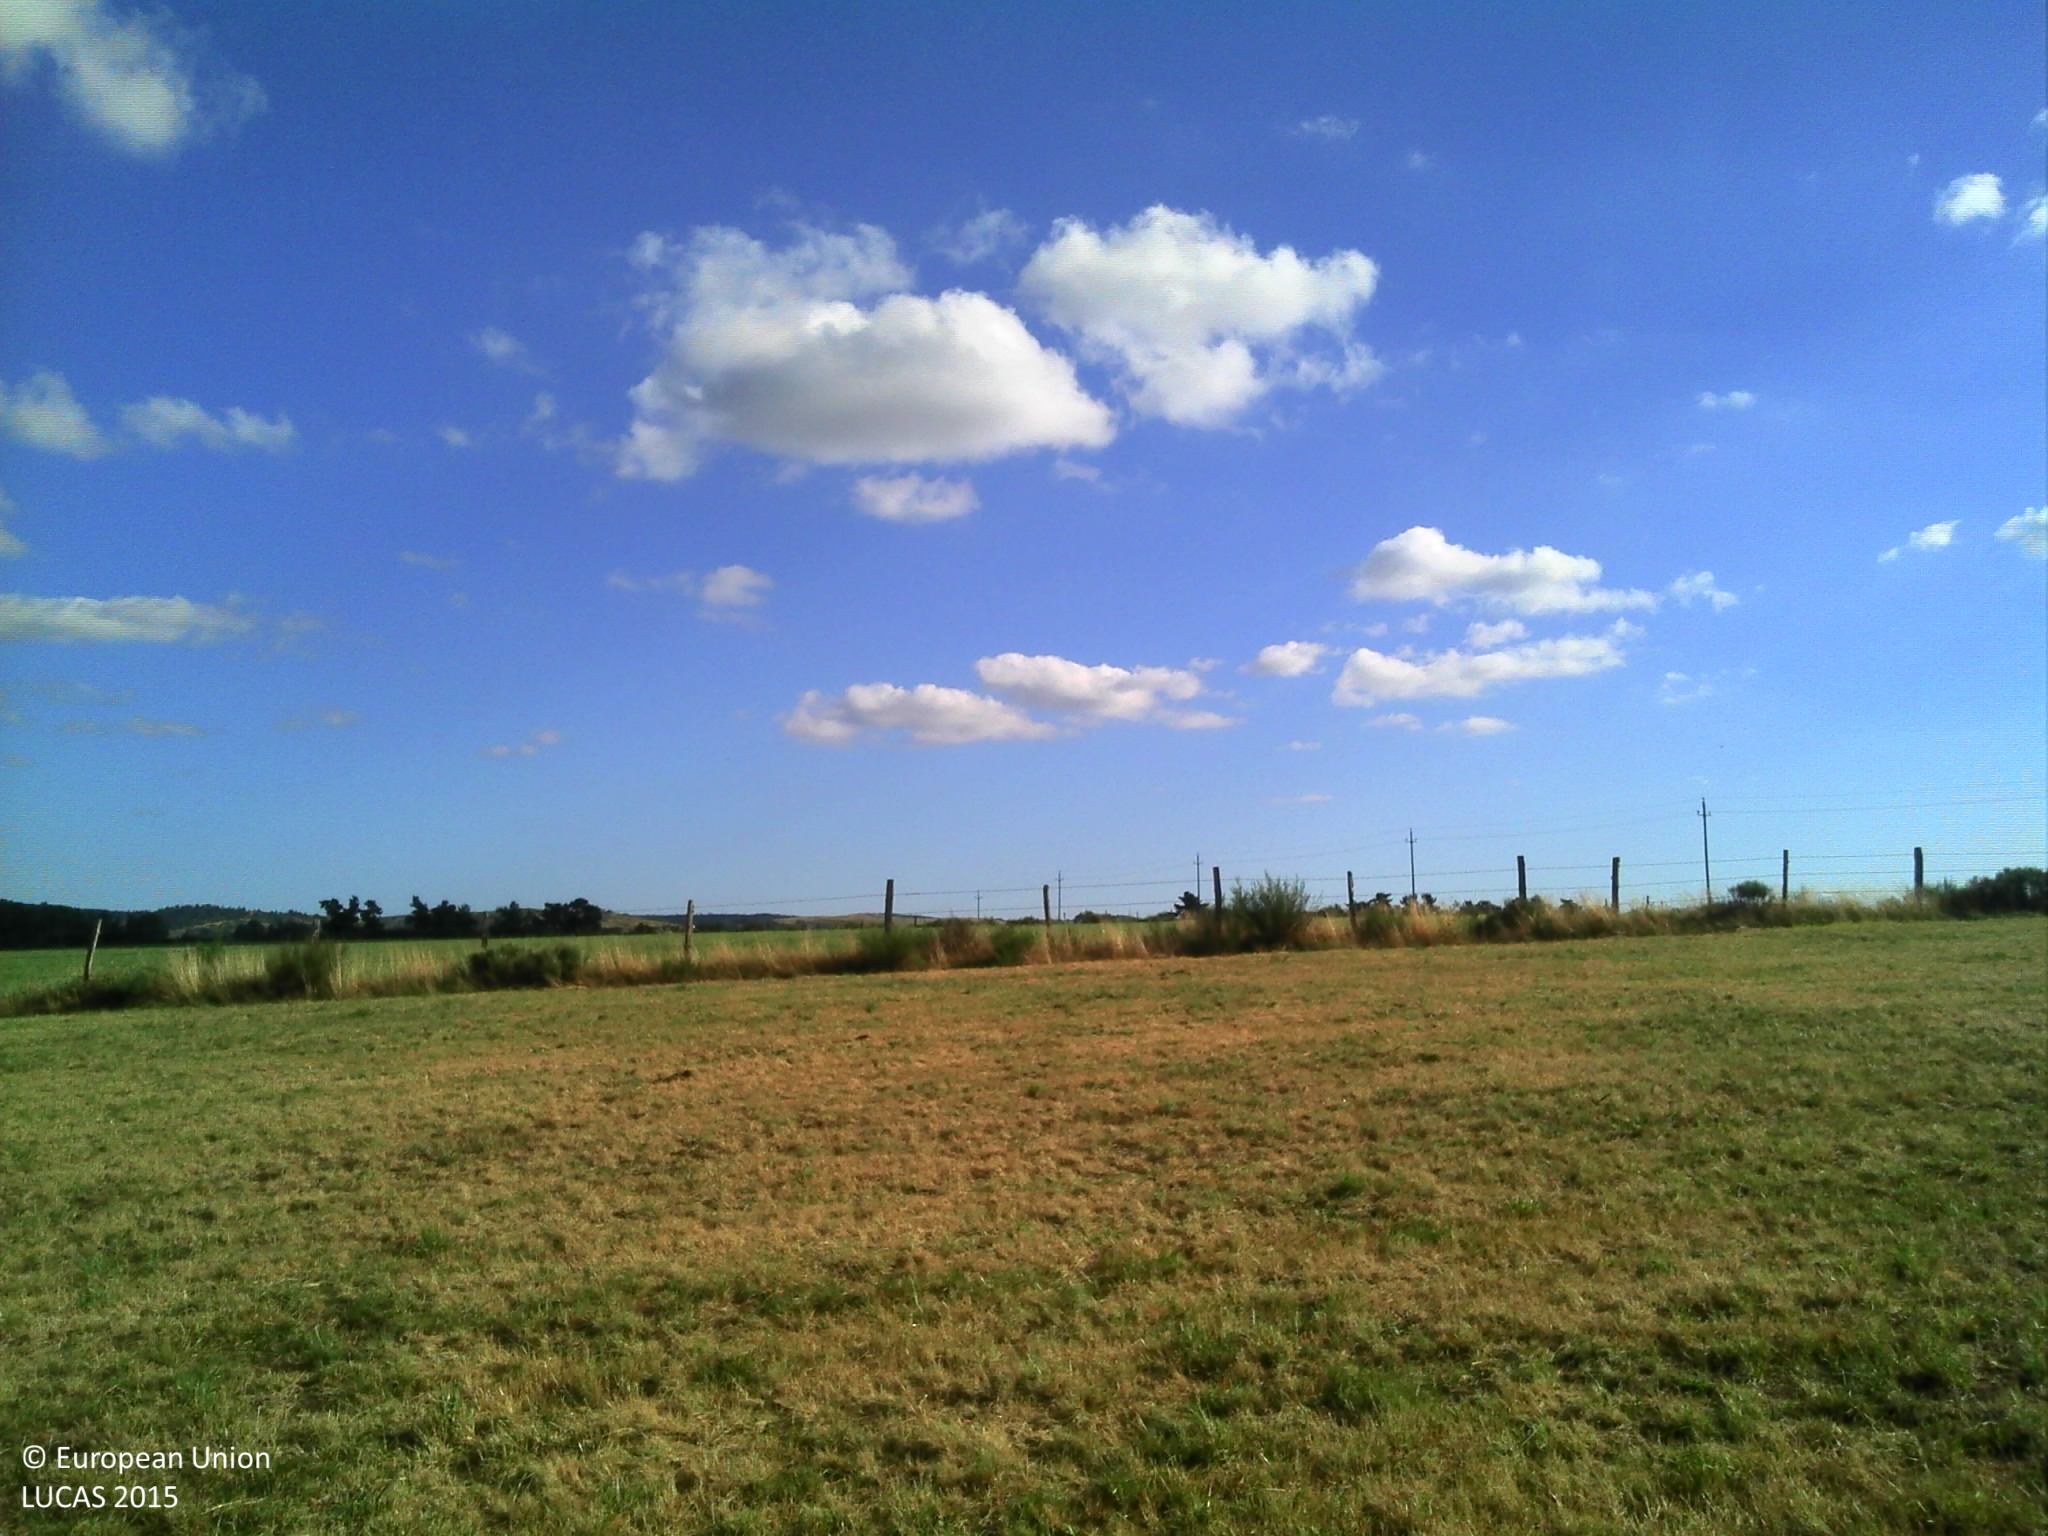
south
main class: Grassland
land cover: Grassland without tree/shrub cover
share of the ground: > 75 %
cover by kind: herbaceous plants 100 %
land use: Agriculture (excluding fallow land and kitchen gardens)
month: July
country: FR
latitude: 44.7227
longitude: 3.1735
